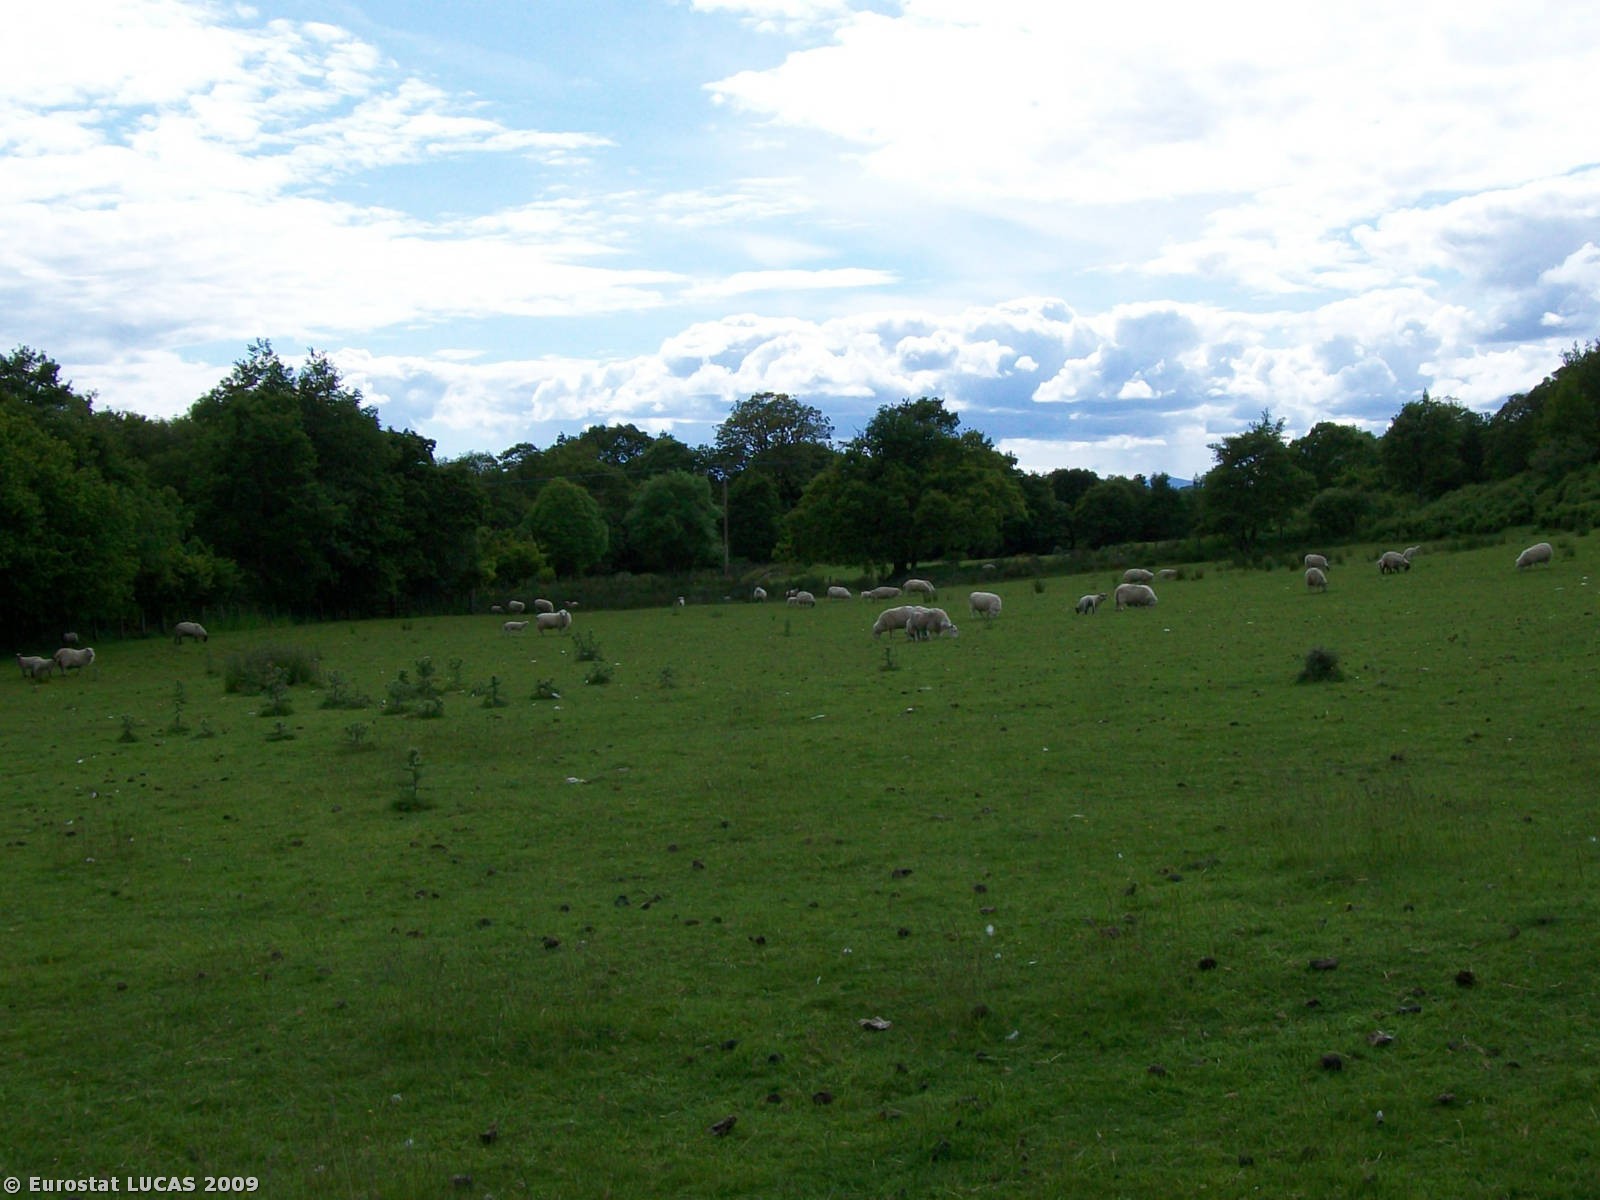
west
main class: Grassland
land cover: Grassland without tree/shrub cover
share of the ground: > 75 %
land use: Agriculture (excluding fallow land and kitchen gardens)
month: June
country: GB
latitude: 56.5360
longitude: -5.3859
